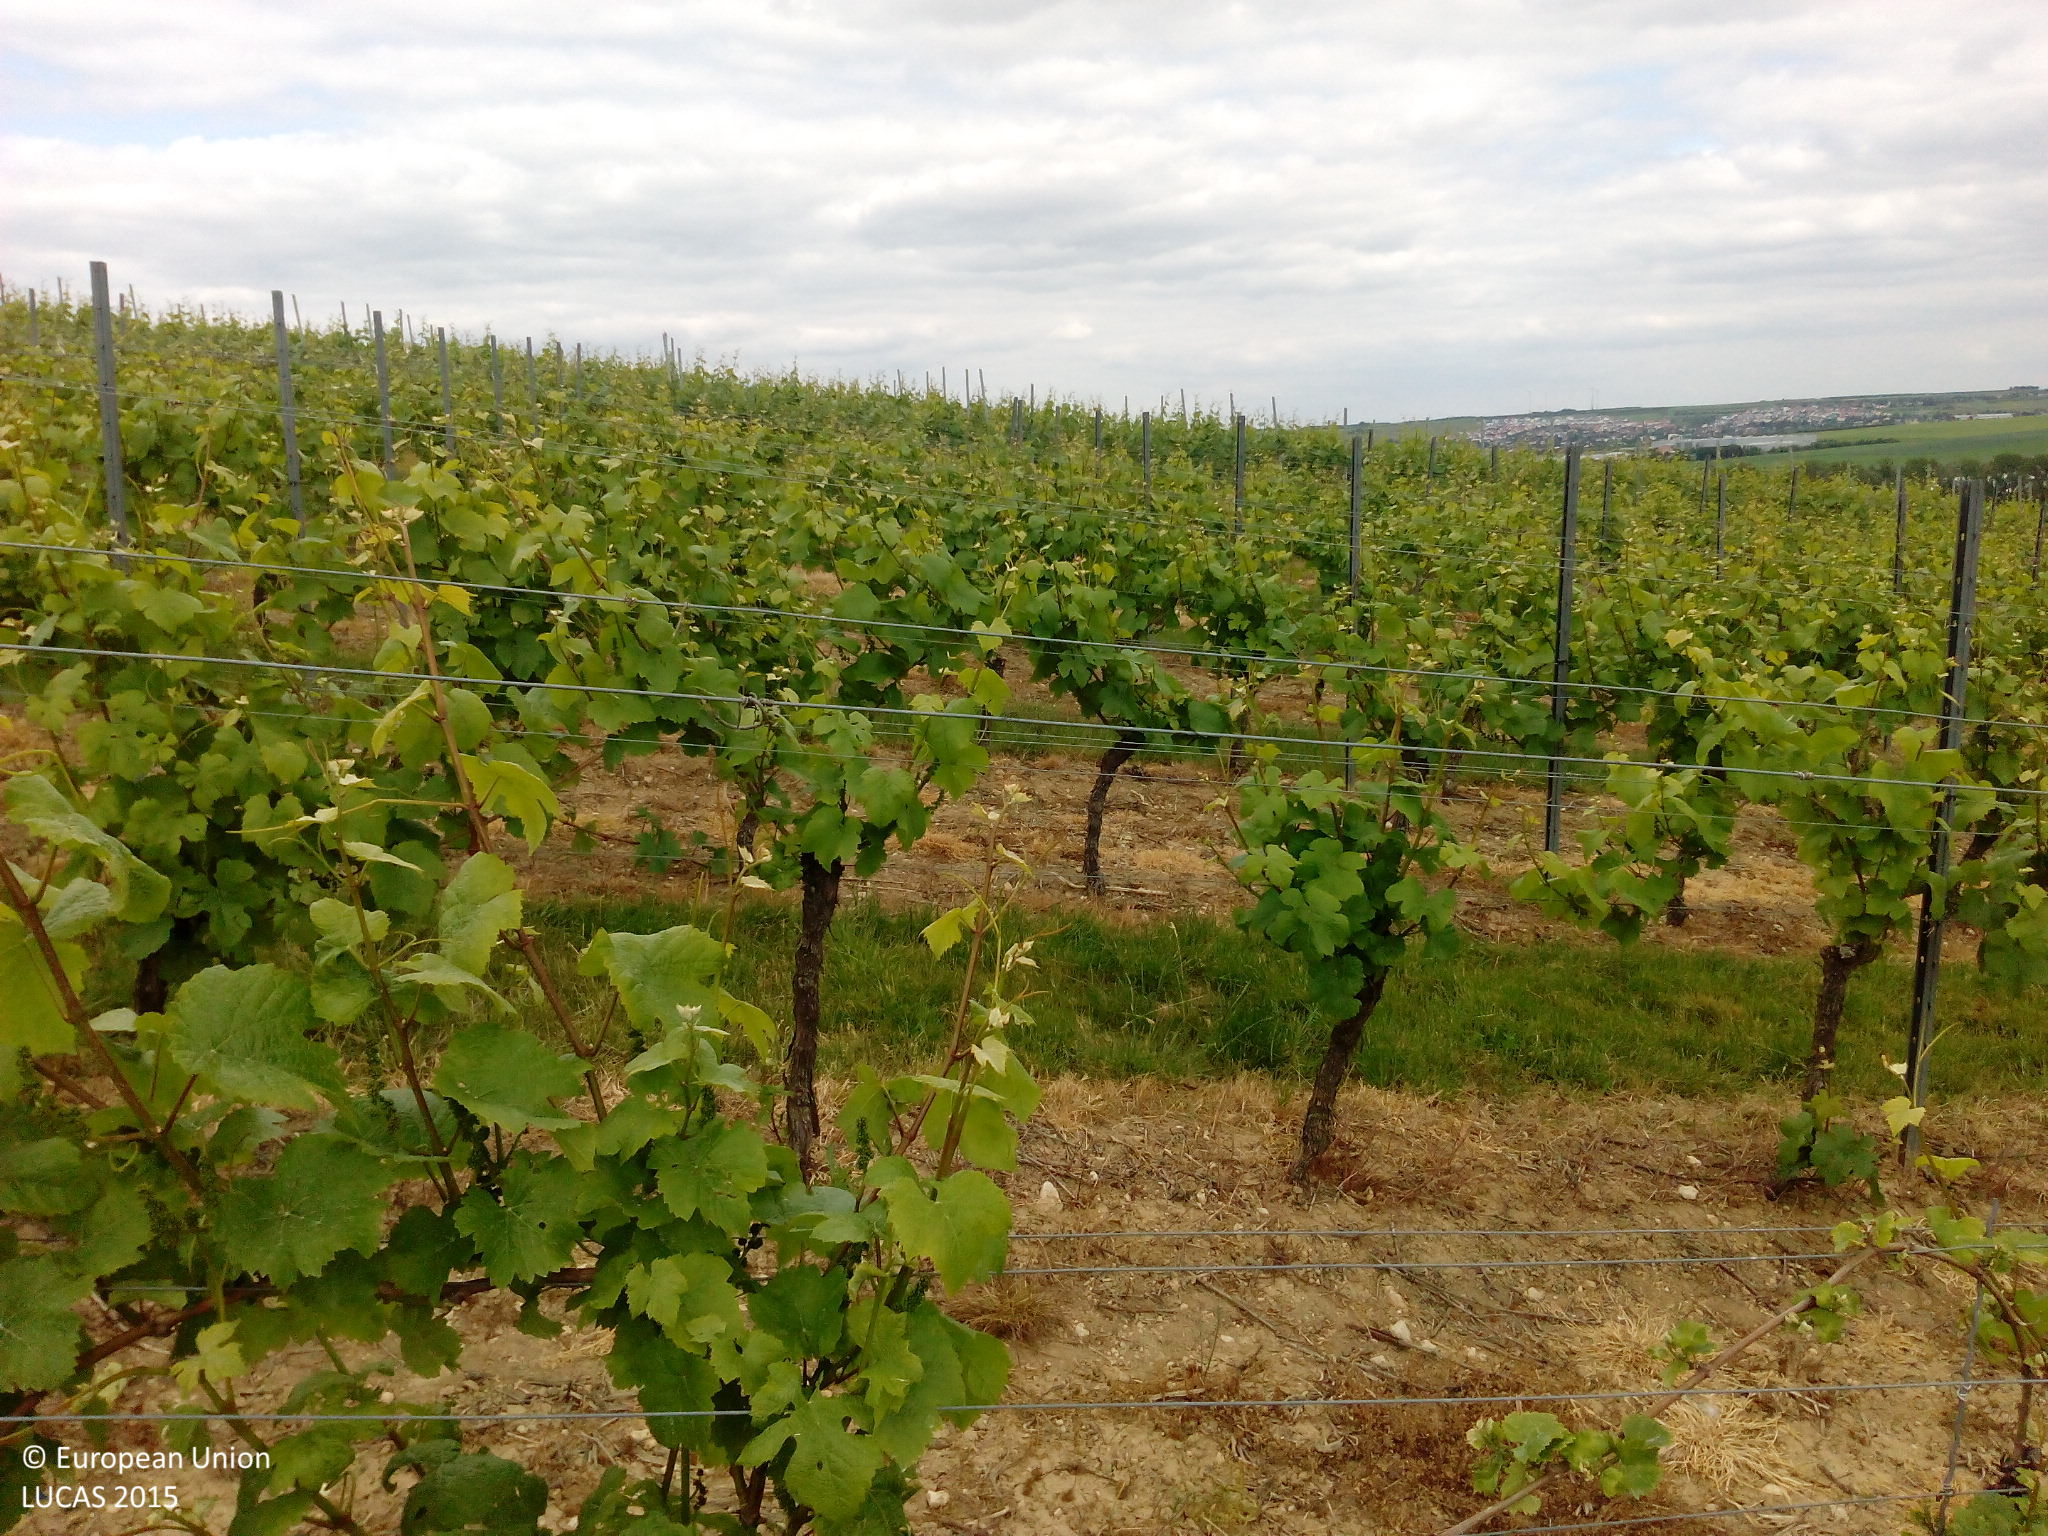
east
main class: Cropland
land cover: Vineyards
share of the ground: 50 - 75 %
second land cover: Grassland without tree/shrub cover
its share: 50 - 75 %
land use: Agriculture (excluding fallow land and kitchen gardens)
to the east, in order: Vineyards; Grassland without tree/shrub cover; Tracks; Vineyards
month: May
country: DE
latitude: 49.9174
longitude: 8.1481
